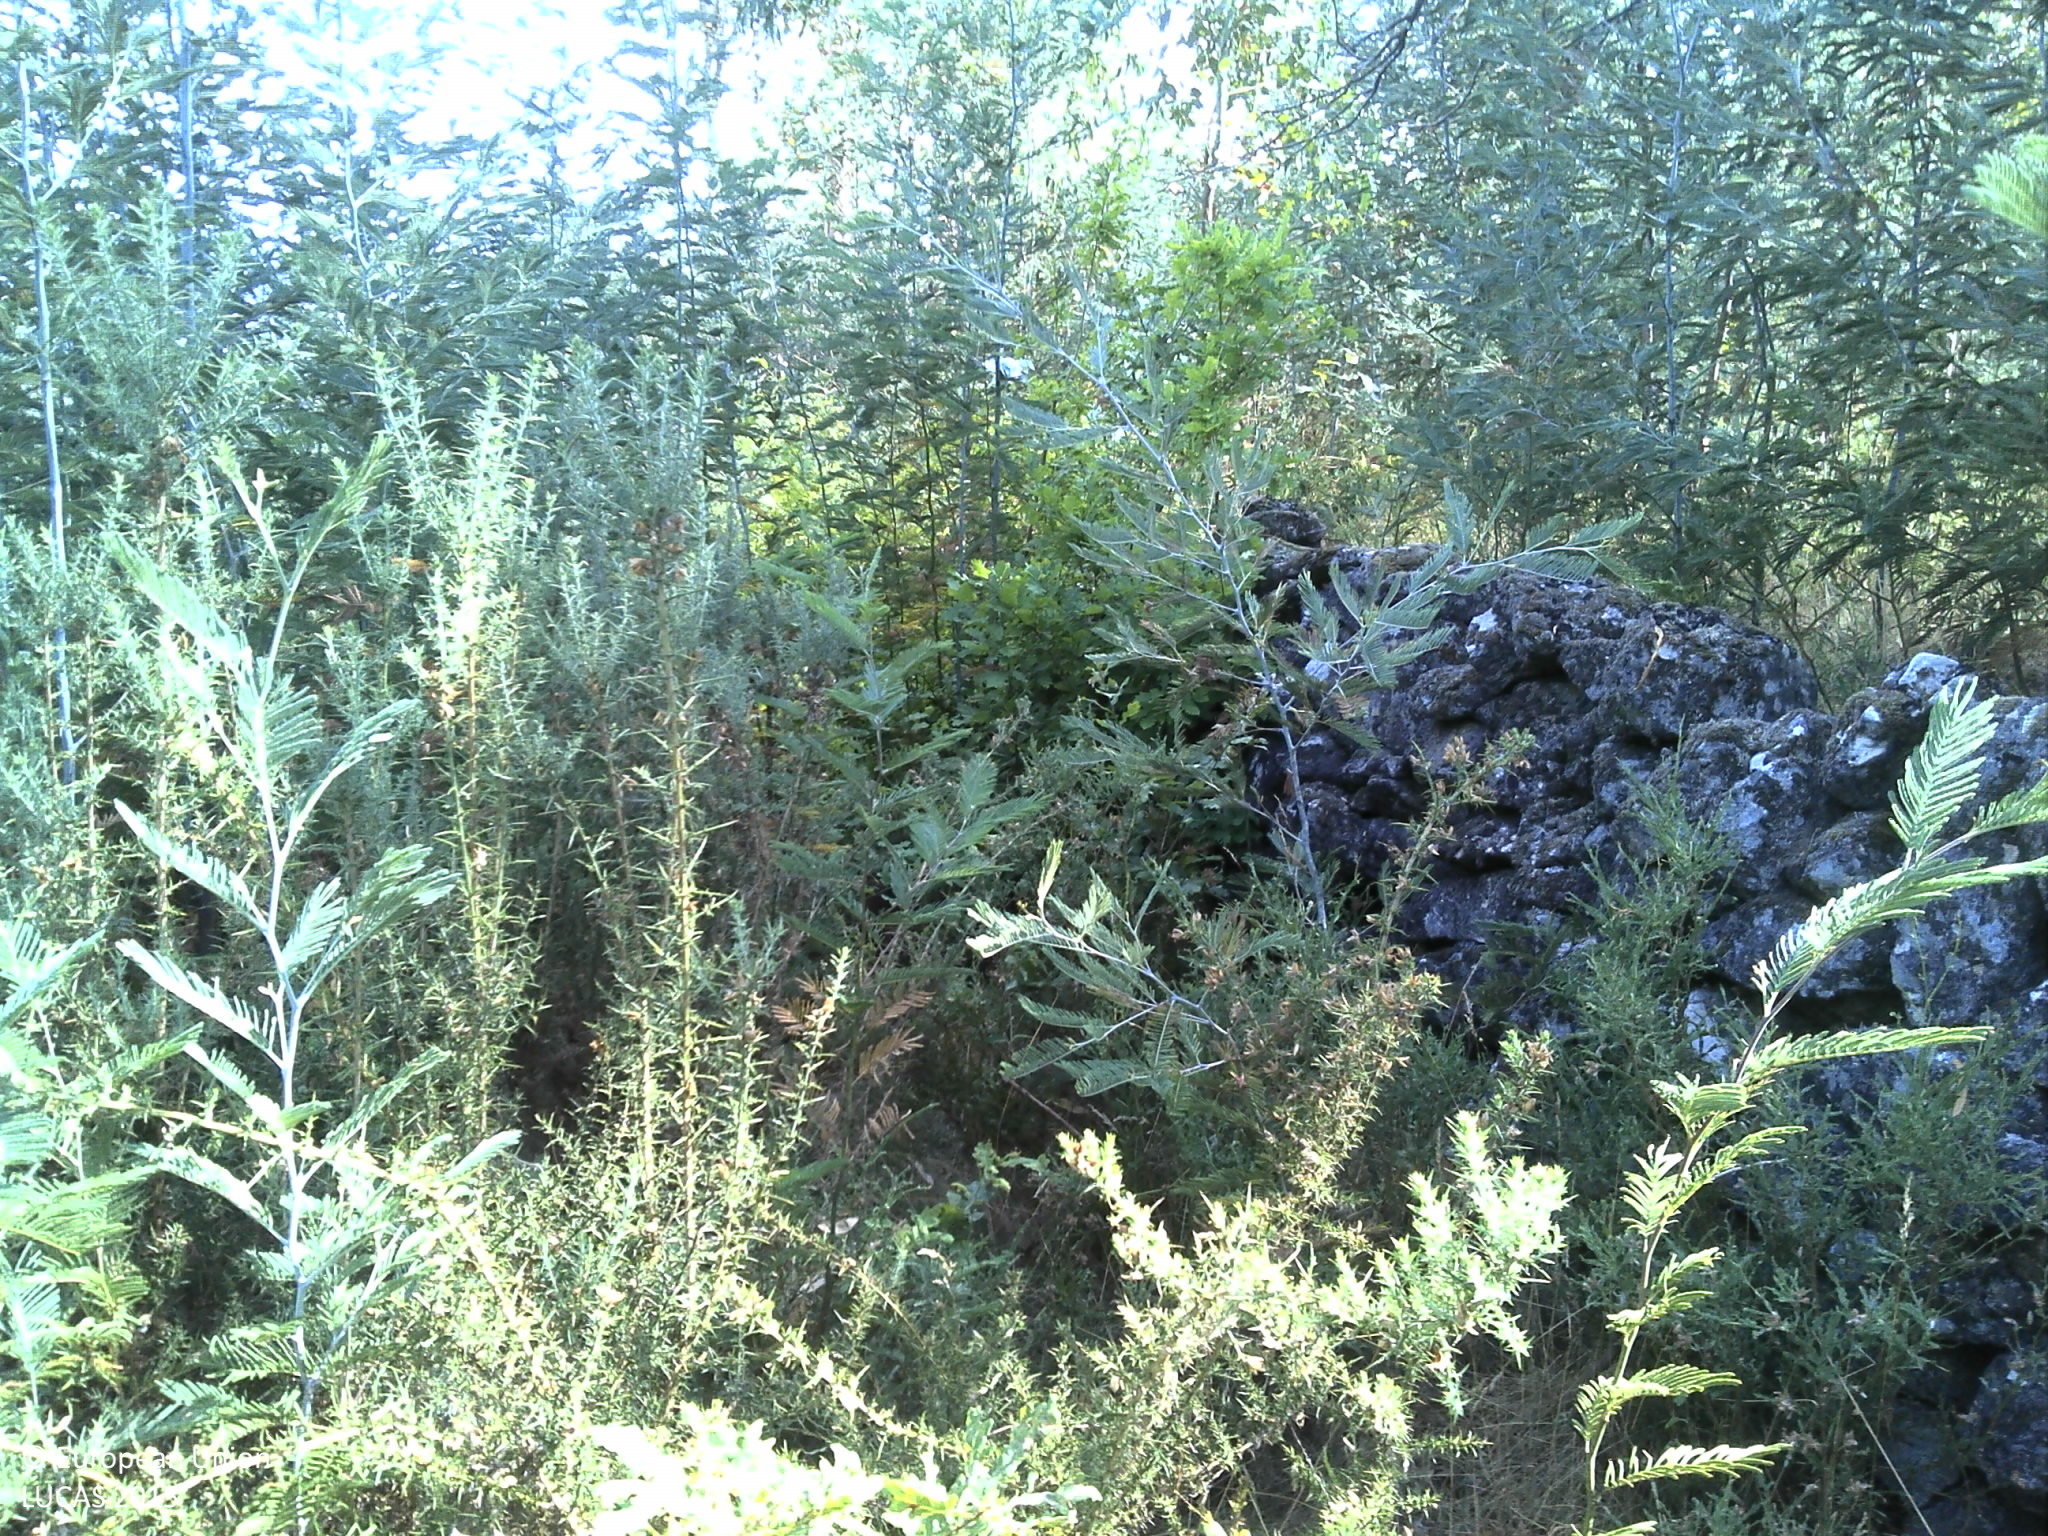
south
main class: Woodland
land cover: Broadleaved woodland
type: exotic forest
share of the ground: 50 - 75 %
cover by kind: broadleaved forest trees 85 %, shrubs 10 %, unconsolidated bare surface 5 %
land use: Forestry
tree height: < 5 m
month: July
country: PT
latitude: 41.6056
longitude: -8.0586
